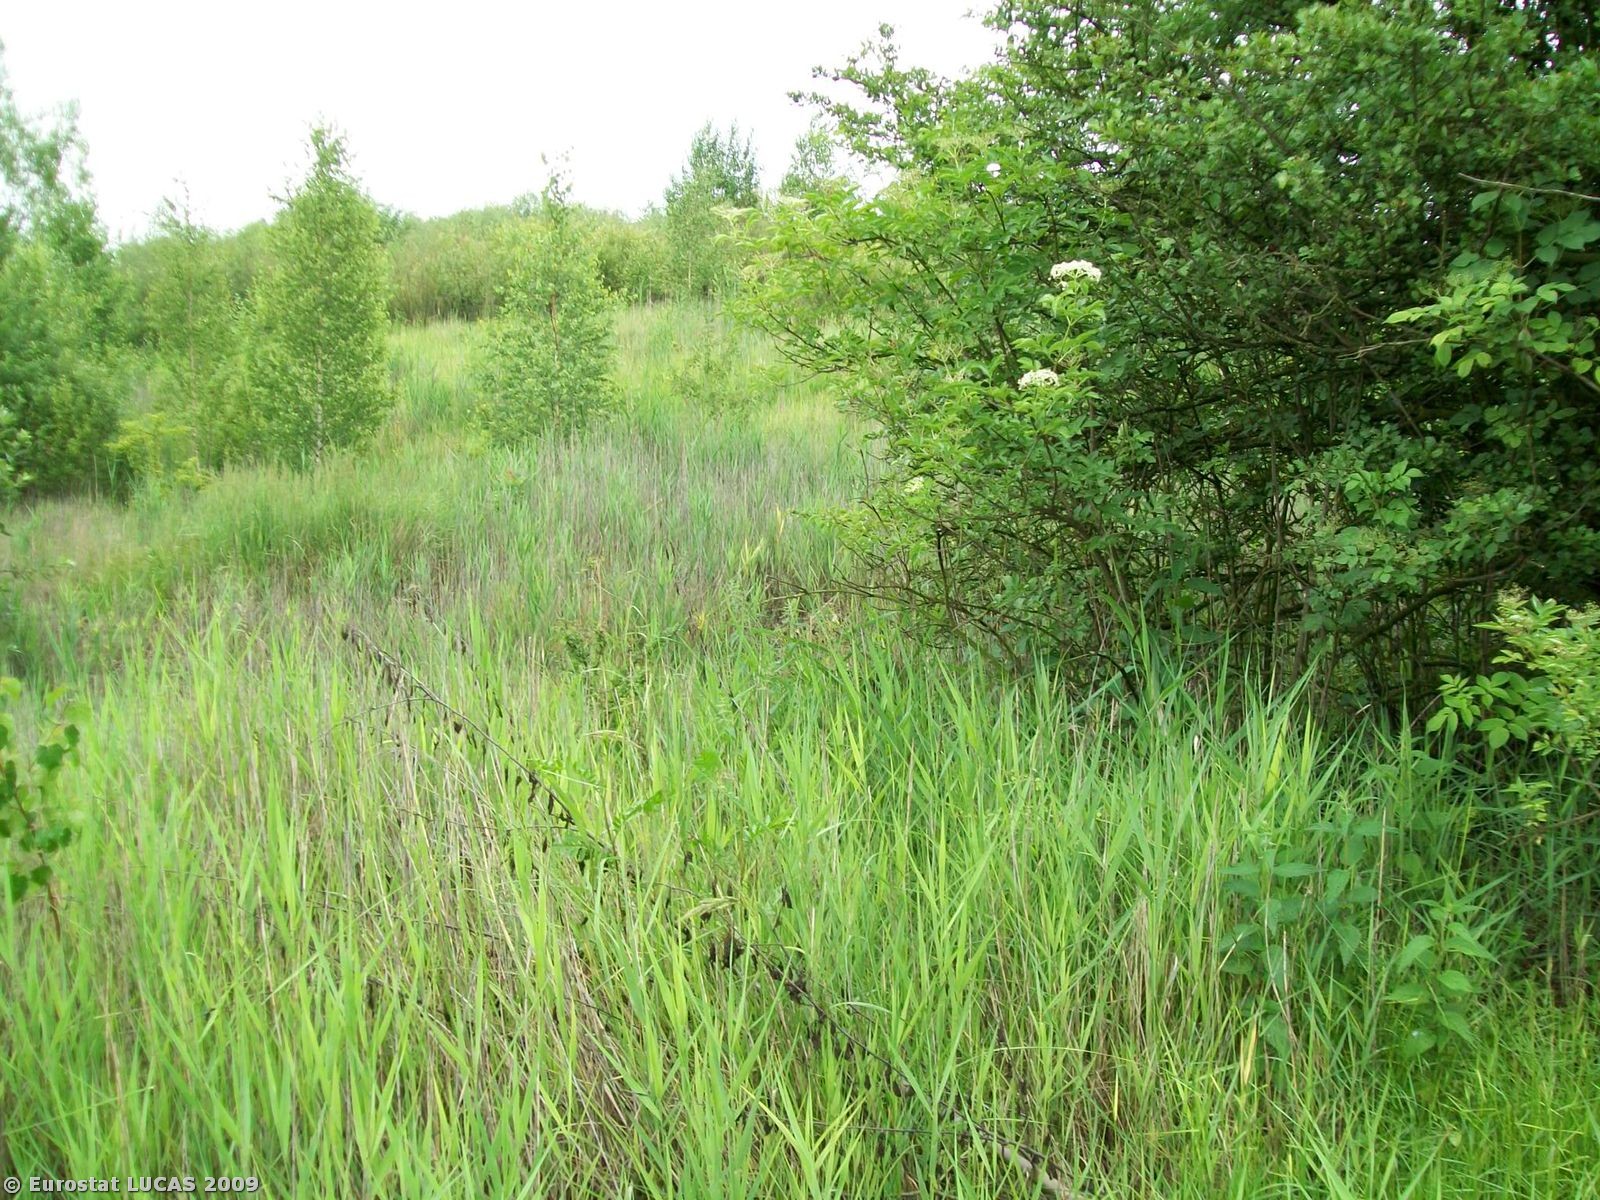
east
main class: Grassland
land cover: Grassland with sparse tree/shrub cover
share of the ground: > 75 %
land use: Unused
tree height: > 5 m
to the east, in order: Grassland with sparse tree/shrub cover; Fences; Artificial constructions in urban areas
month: June
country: PL
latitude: 51.1921
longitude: 16.1163
